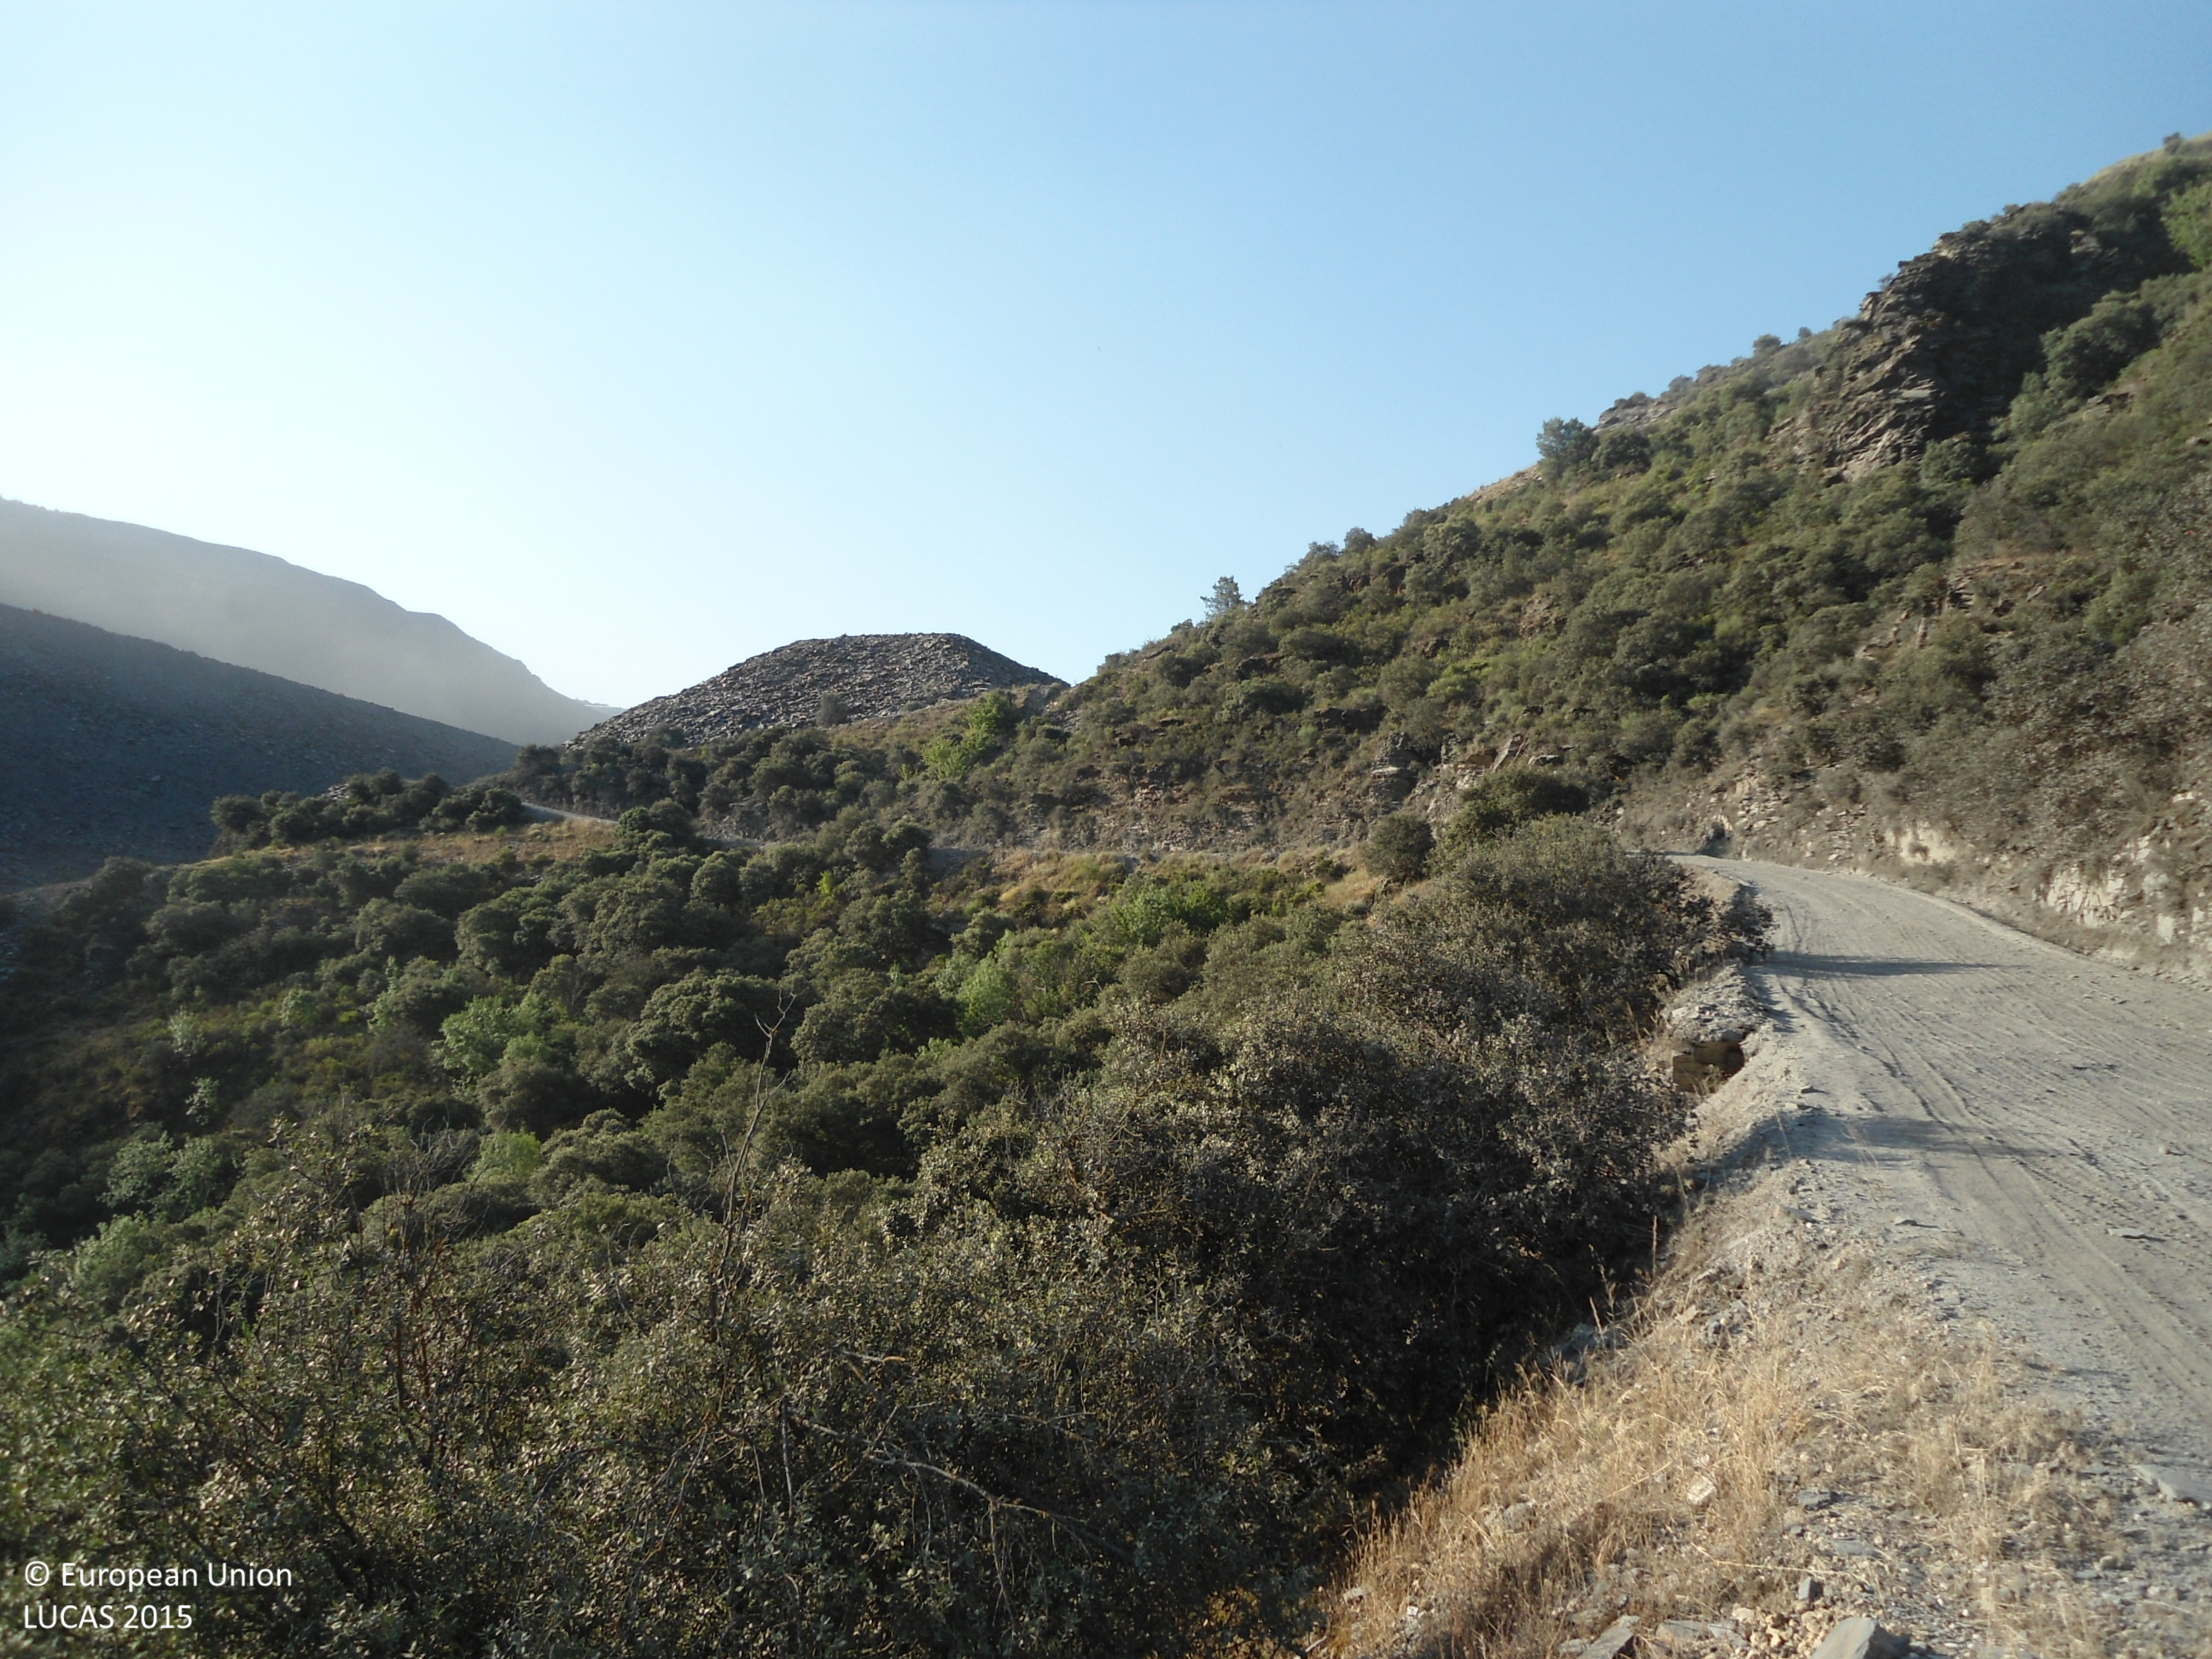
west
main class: Shrubland
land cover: Shrubland with sparse tree cover
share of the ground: > 75 %
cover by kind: shrubs 95 %, broadleaved forest trees 5 %
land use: Semi-natural and natural areas not in use
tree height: > 5 m
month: June
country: ES
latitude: 42.3724
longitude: -6.8454
